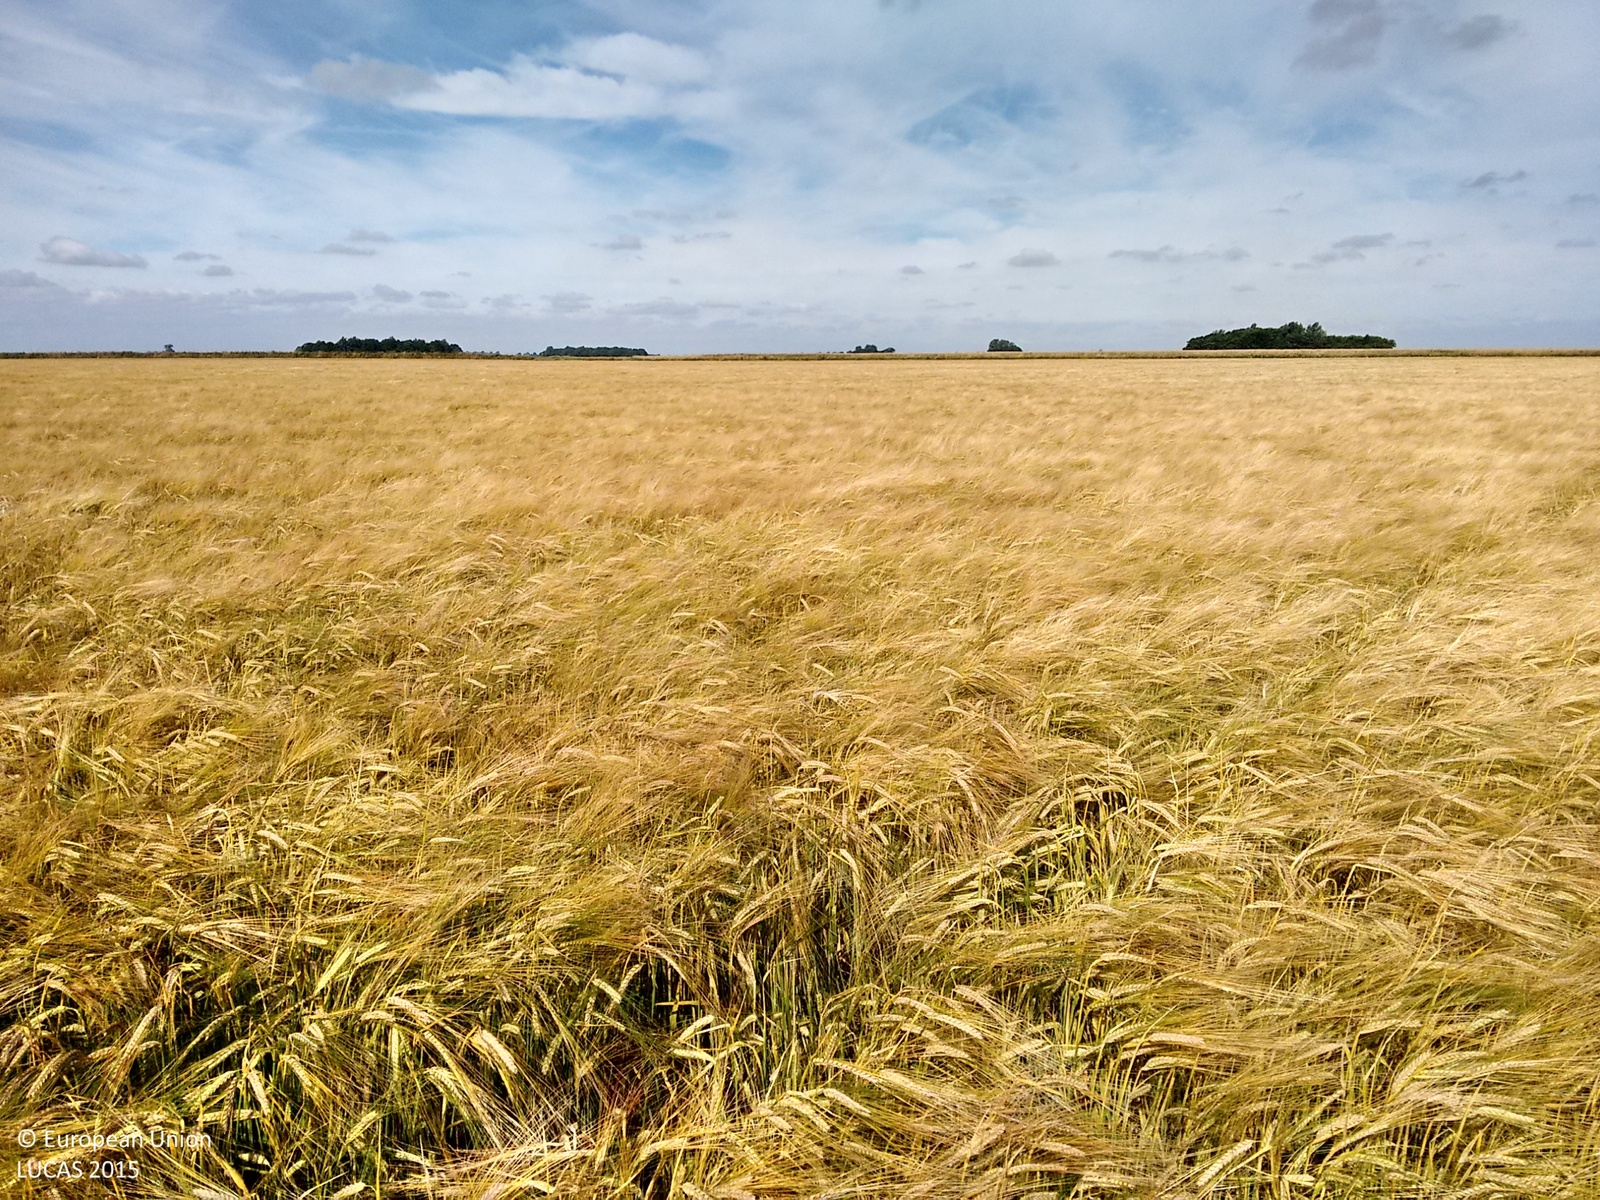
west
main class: Cropland
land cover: Barley
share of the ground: > 75 %
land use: Agriculture (excluding fallow land and kitchen gardens)
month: August
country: GB
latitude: 52.7957
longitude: 0.3162
